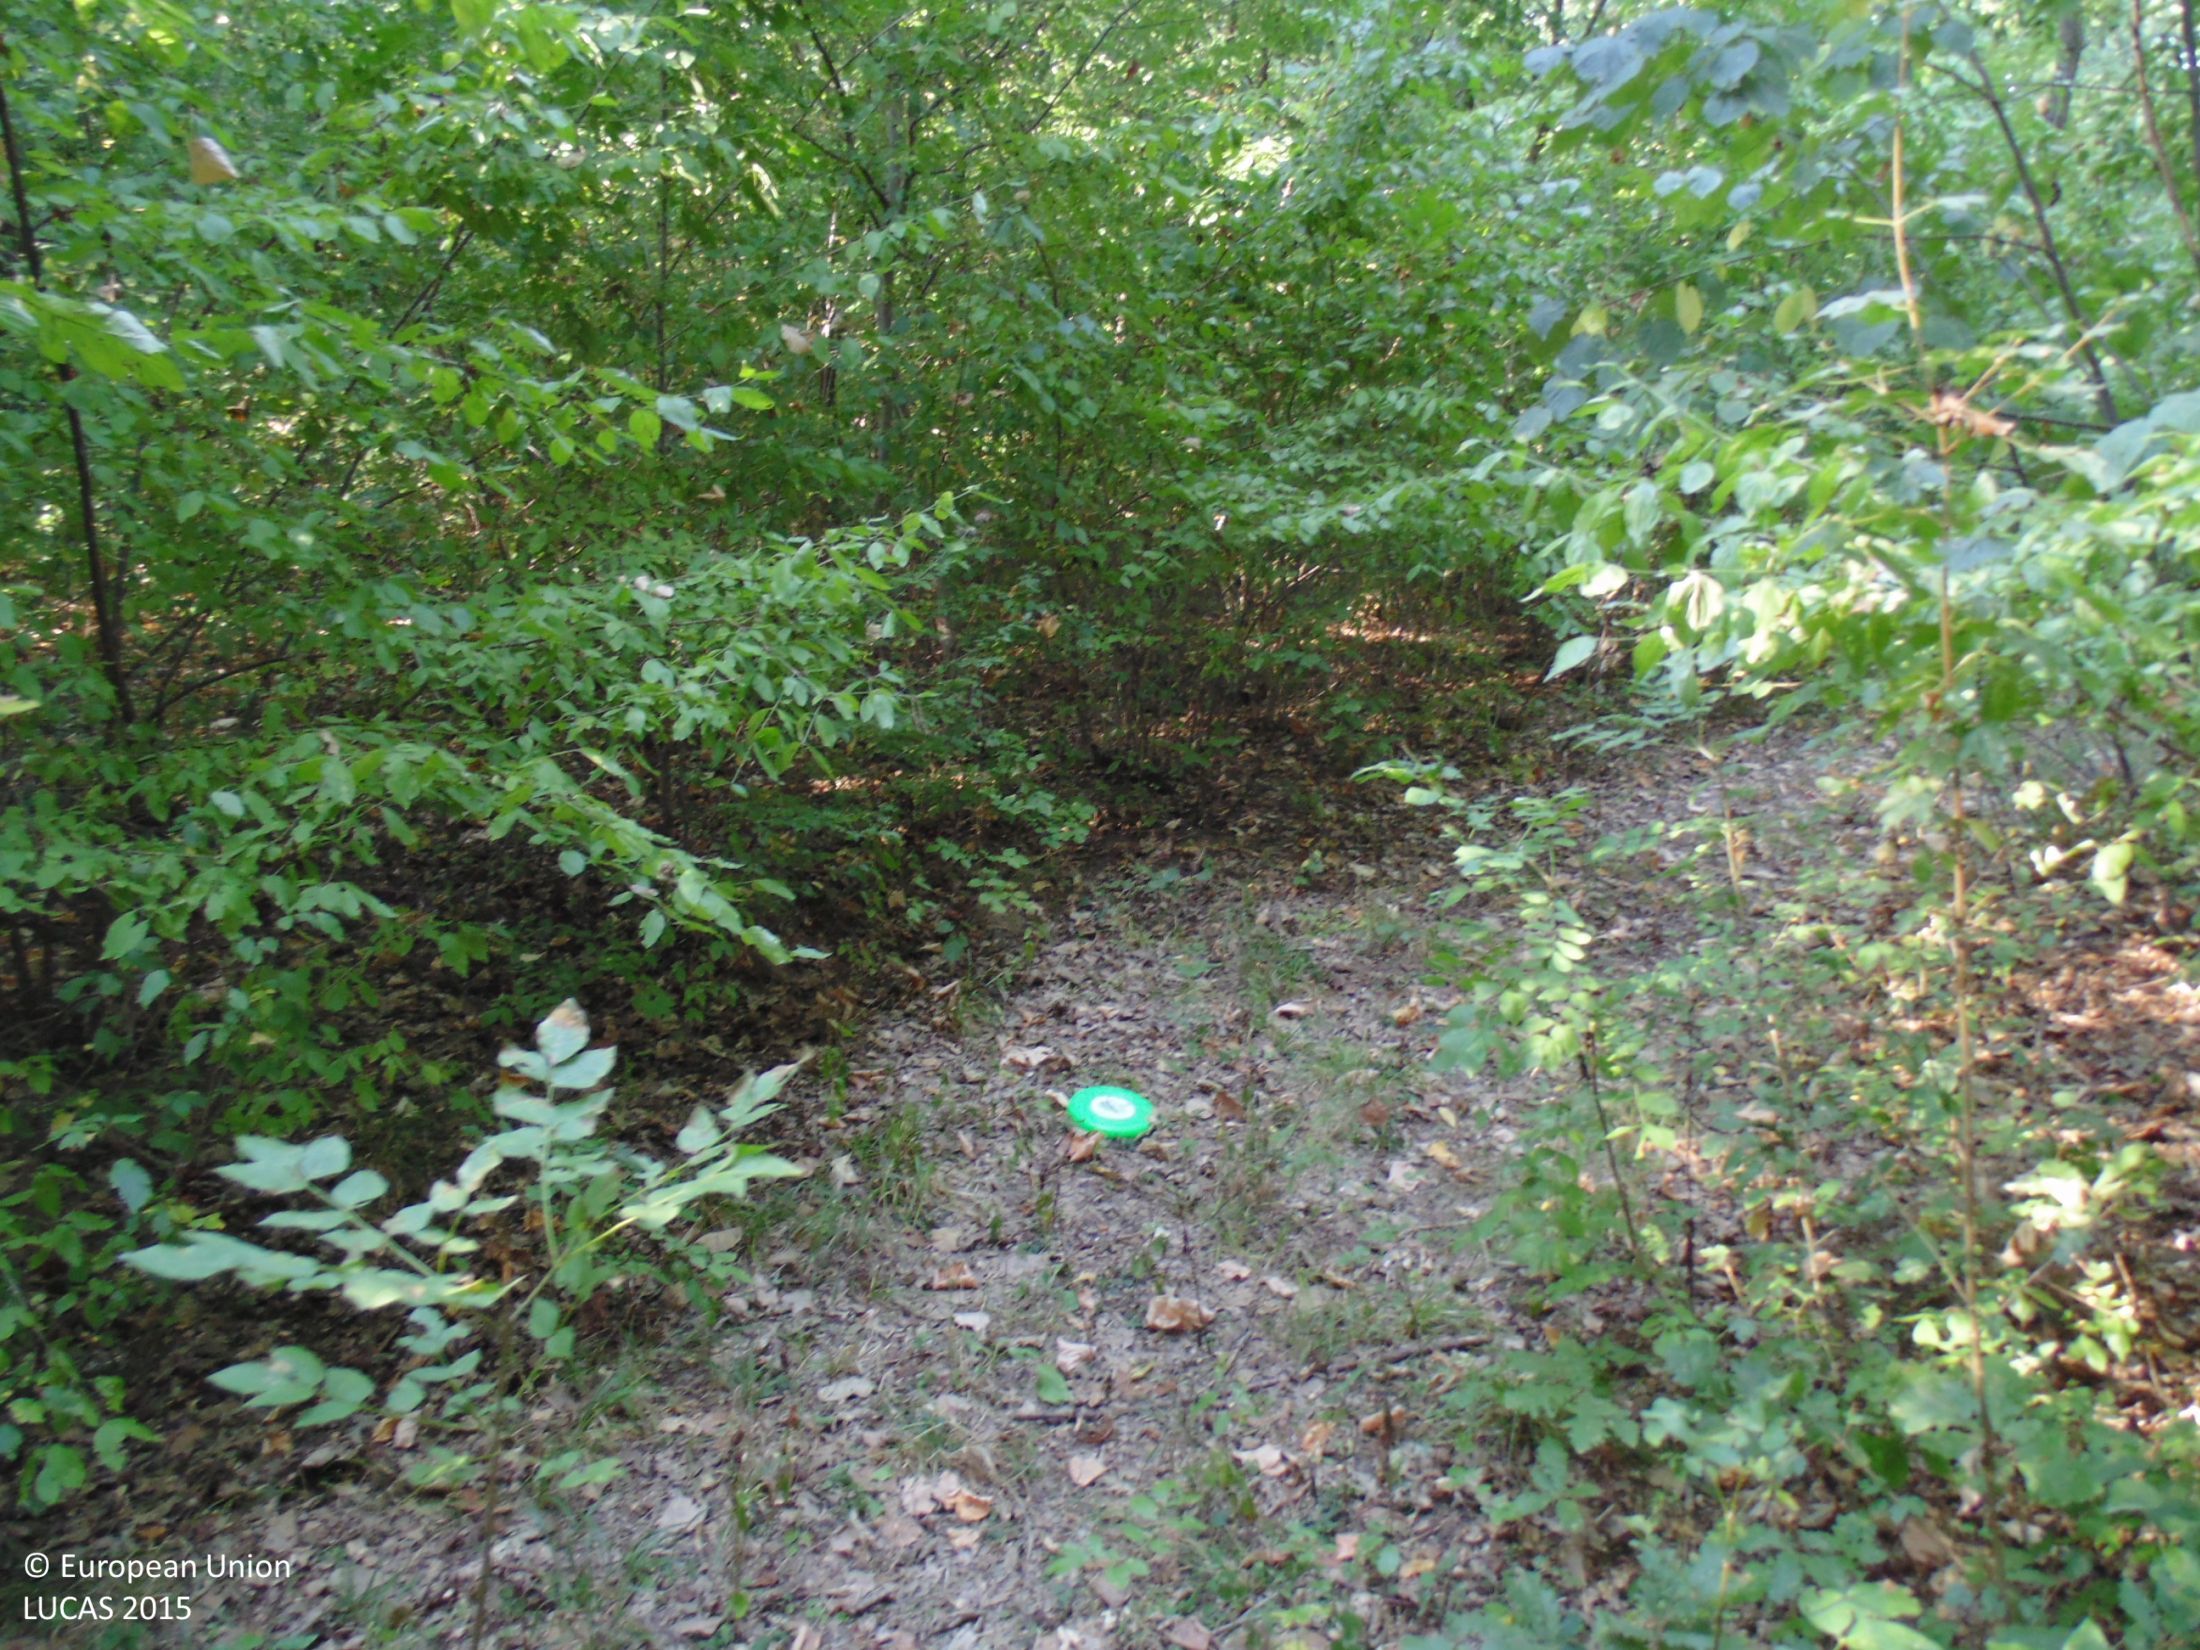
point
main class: Woodland
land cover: Broadleaved woodland
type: mesophytic deciduous forest
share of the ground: > 75 %
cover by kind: broadleaved forest trees 90 %, shrubs 5 %, unconsolidated bare surface 5 %
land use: Forestry
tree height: > 5 m
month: September
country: BG
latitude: 43.8534
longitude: 26.9009
